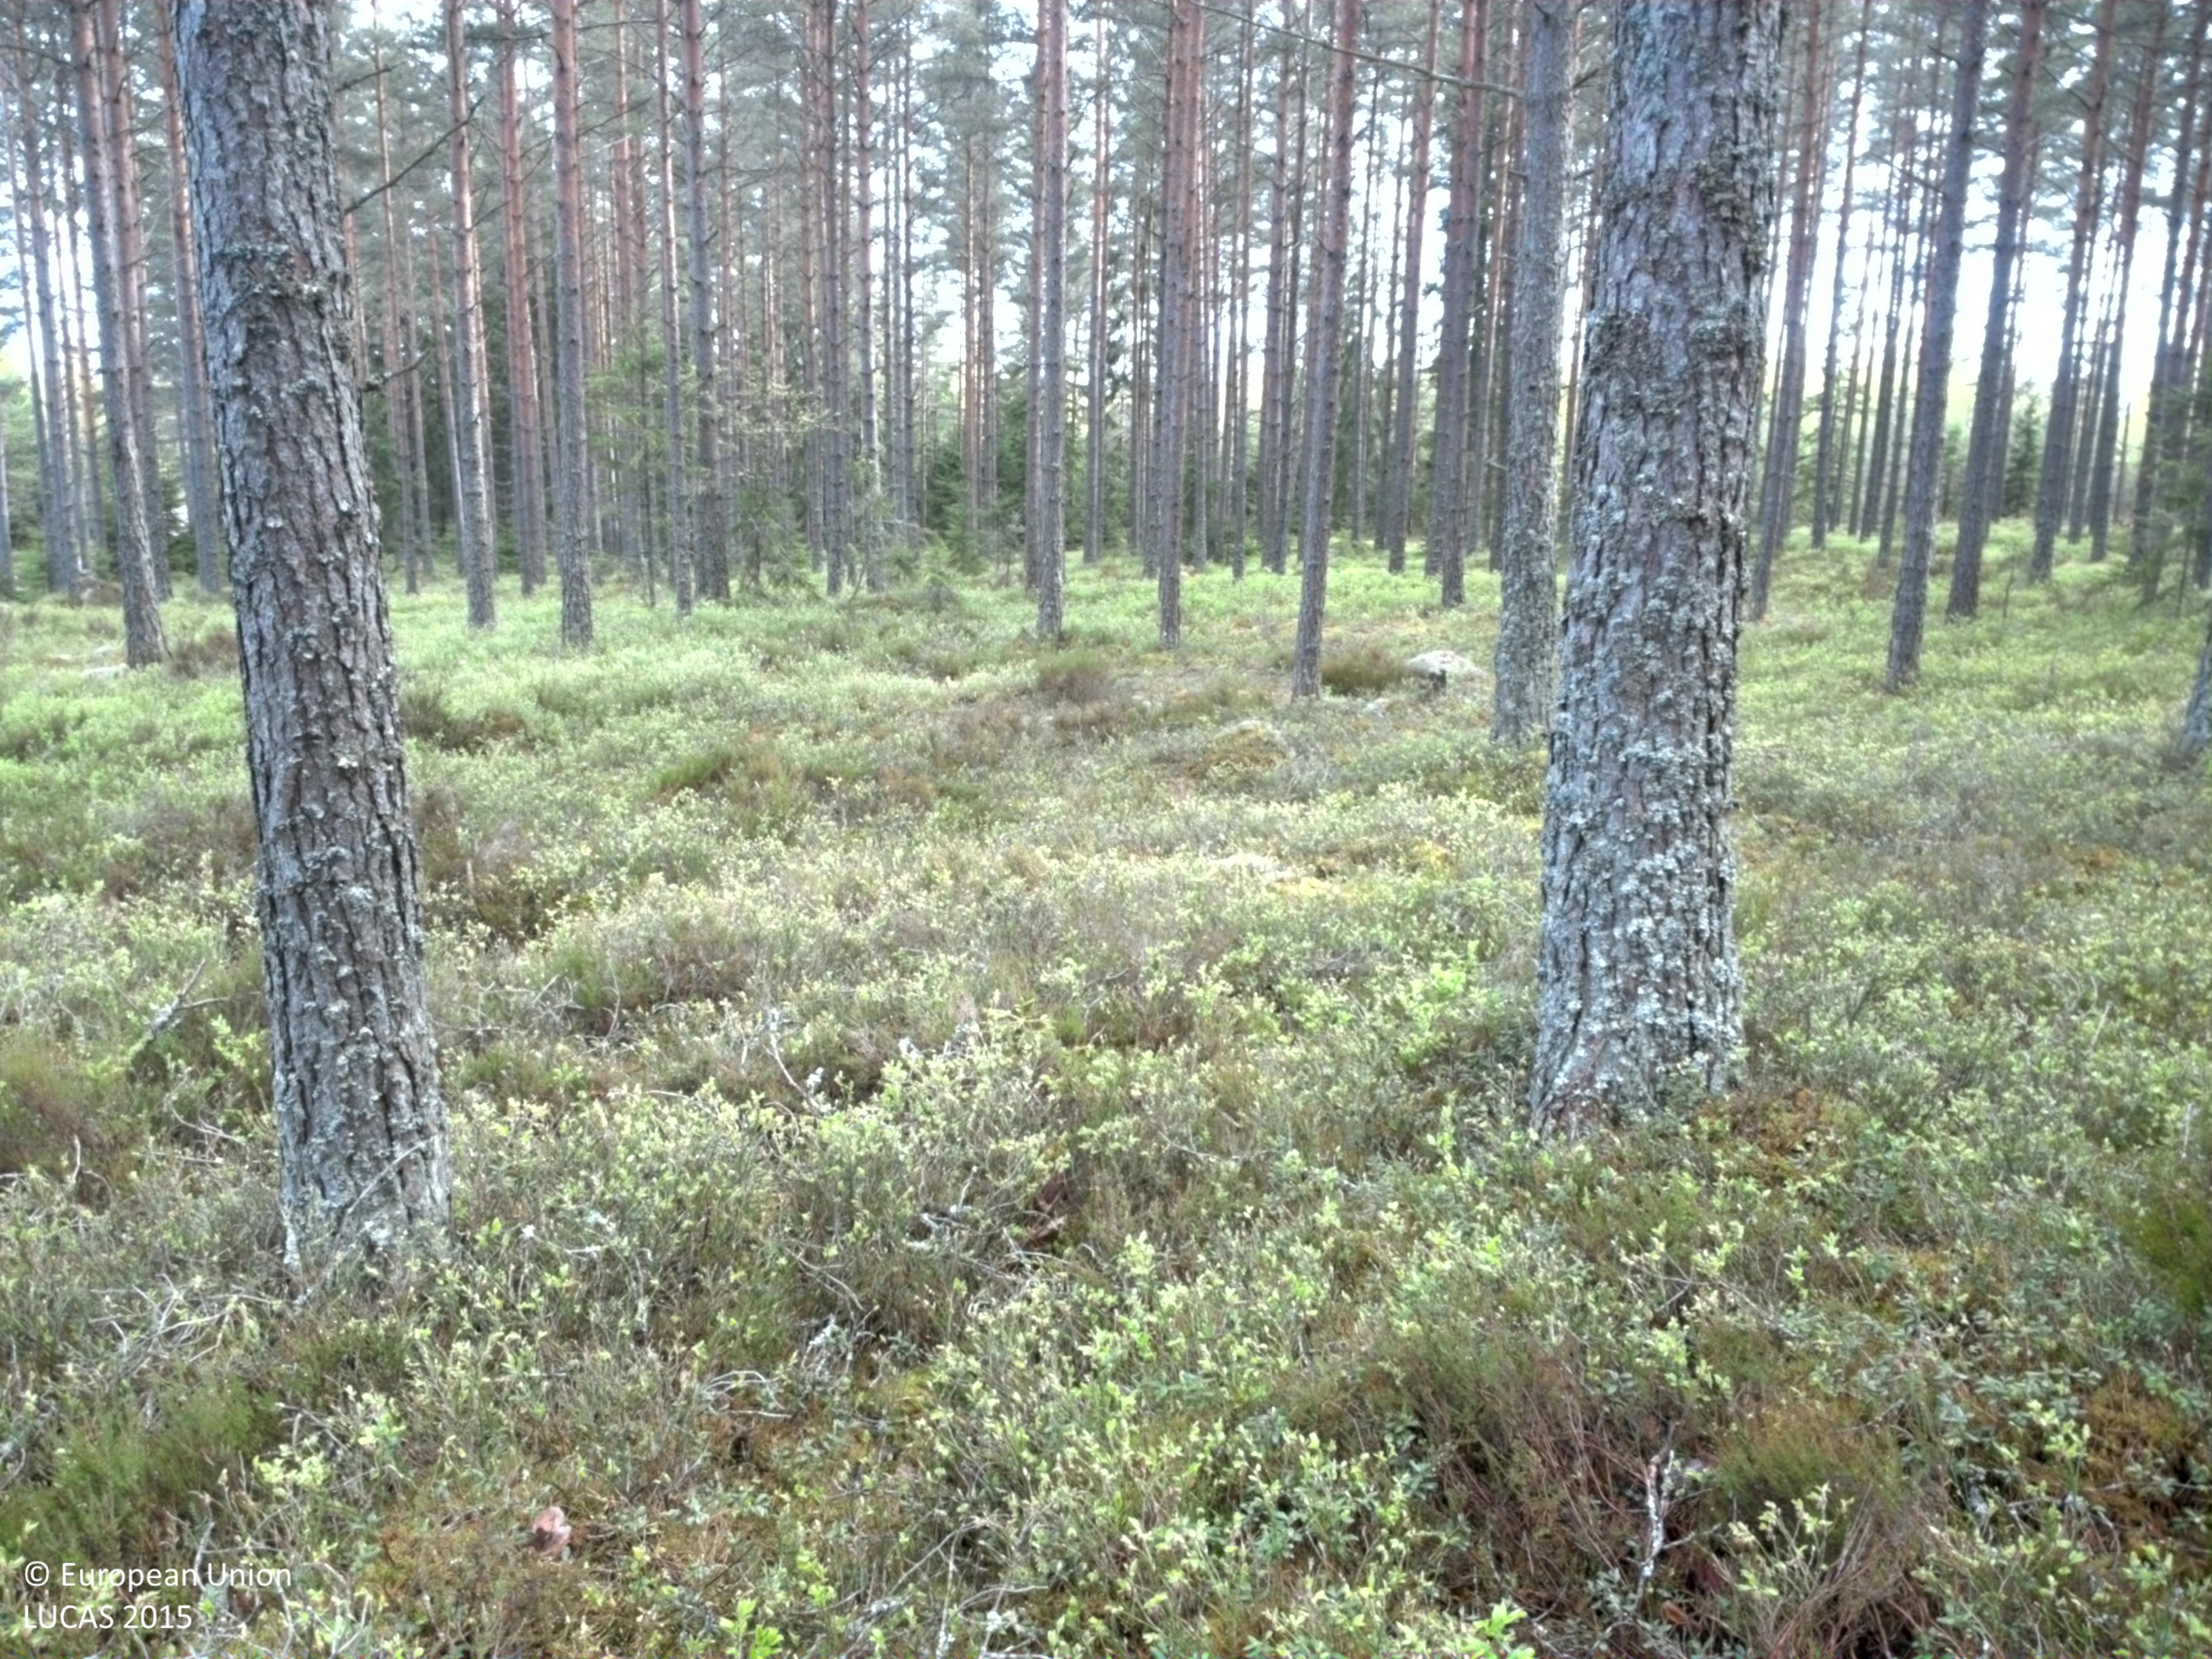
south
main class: Woodland
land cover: Pine dominated coniferous woodland
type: boreal forest
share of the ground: 50 - 75 %
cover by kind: coniferous forest trees 50 %, shrubs 40 %, herbaceous plants 5 %, lichens and mosses 5 %
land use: Forestry
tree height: > 5 m
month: May
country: SE
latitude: 59.1583
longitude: 14.3464
